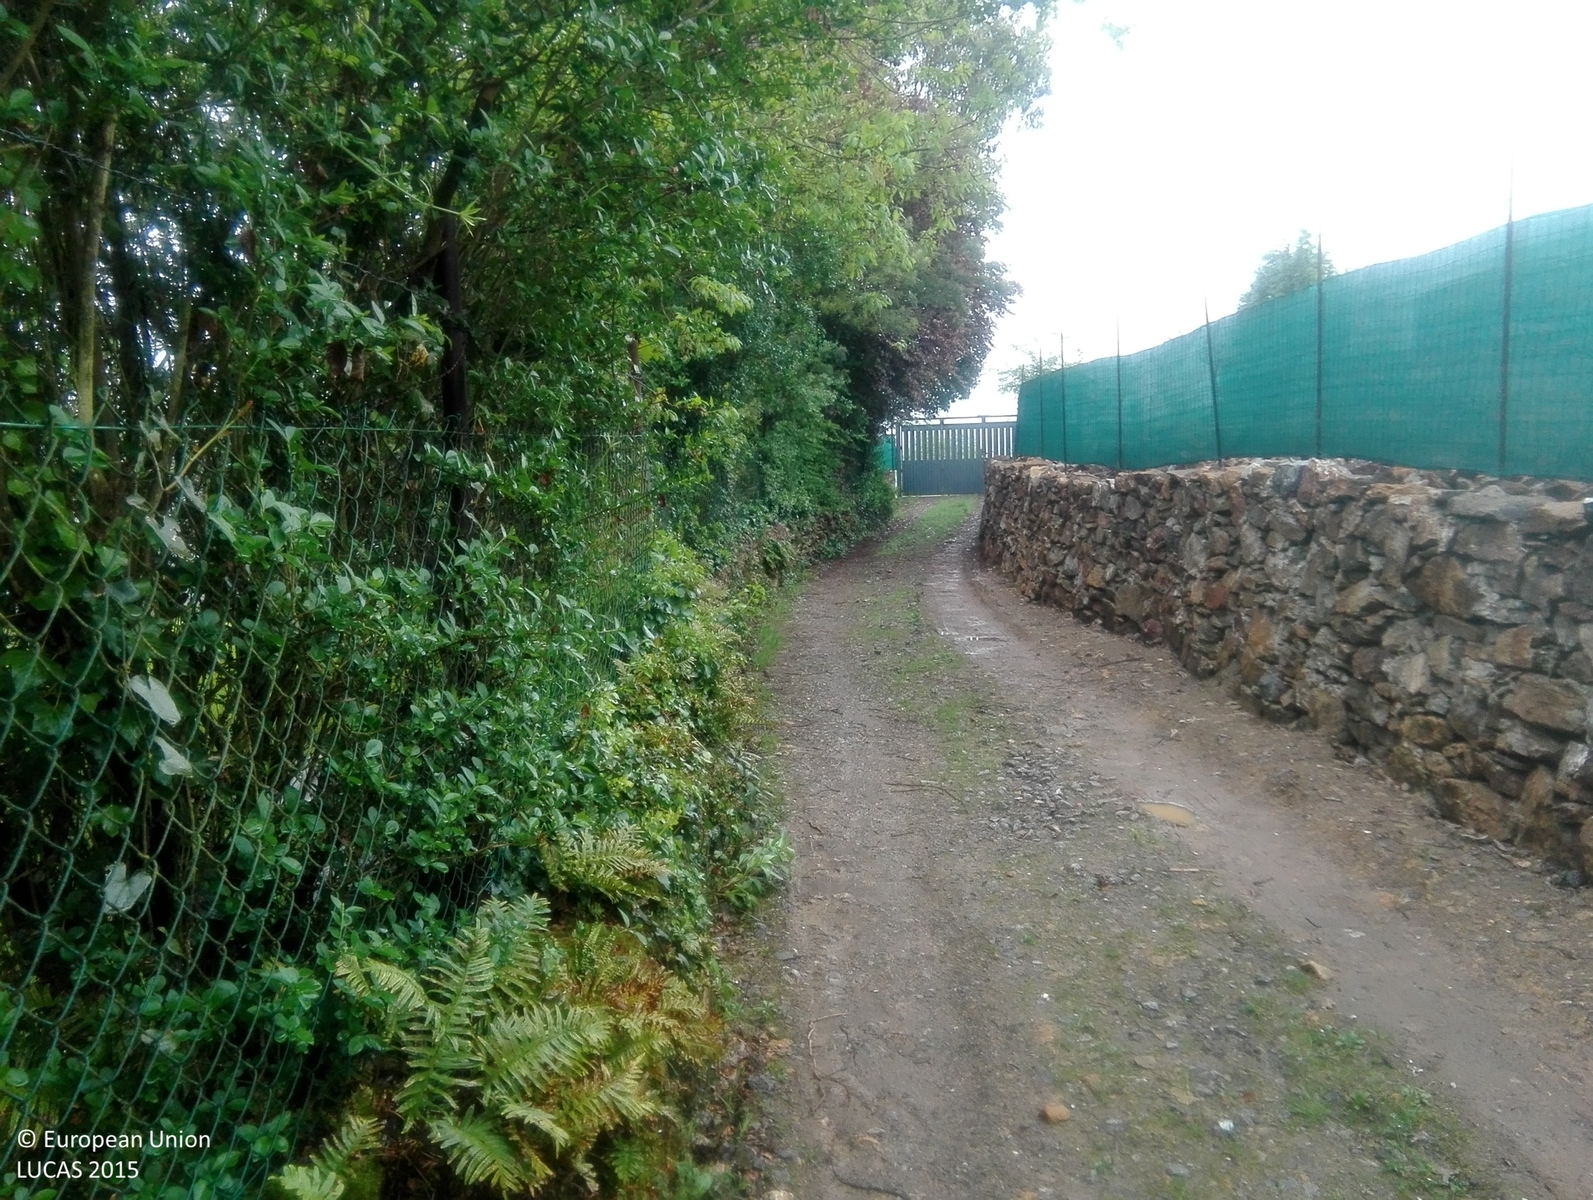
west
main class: Cropland
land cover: Apple fruit
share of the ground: 50 - 75 %
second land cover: Grassland without tree/shrub cover
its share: > 75 %
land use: Kitchen garden
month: April
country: ES
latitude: 43.3472
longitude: -5.9419
